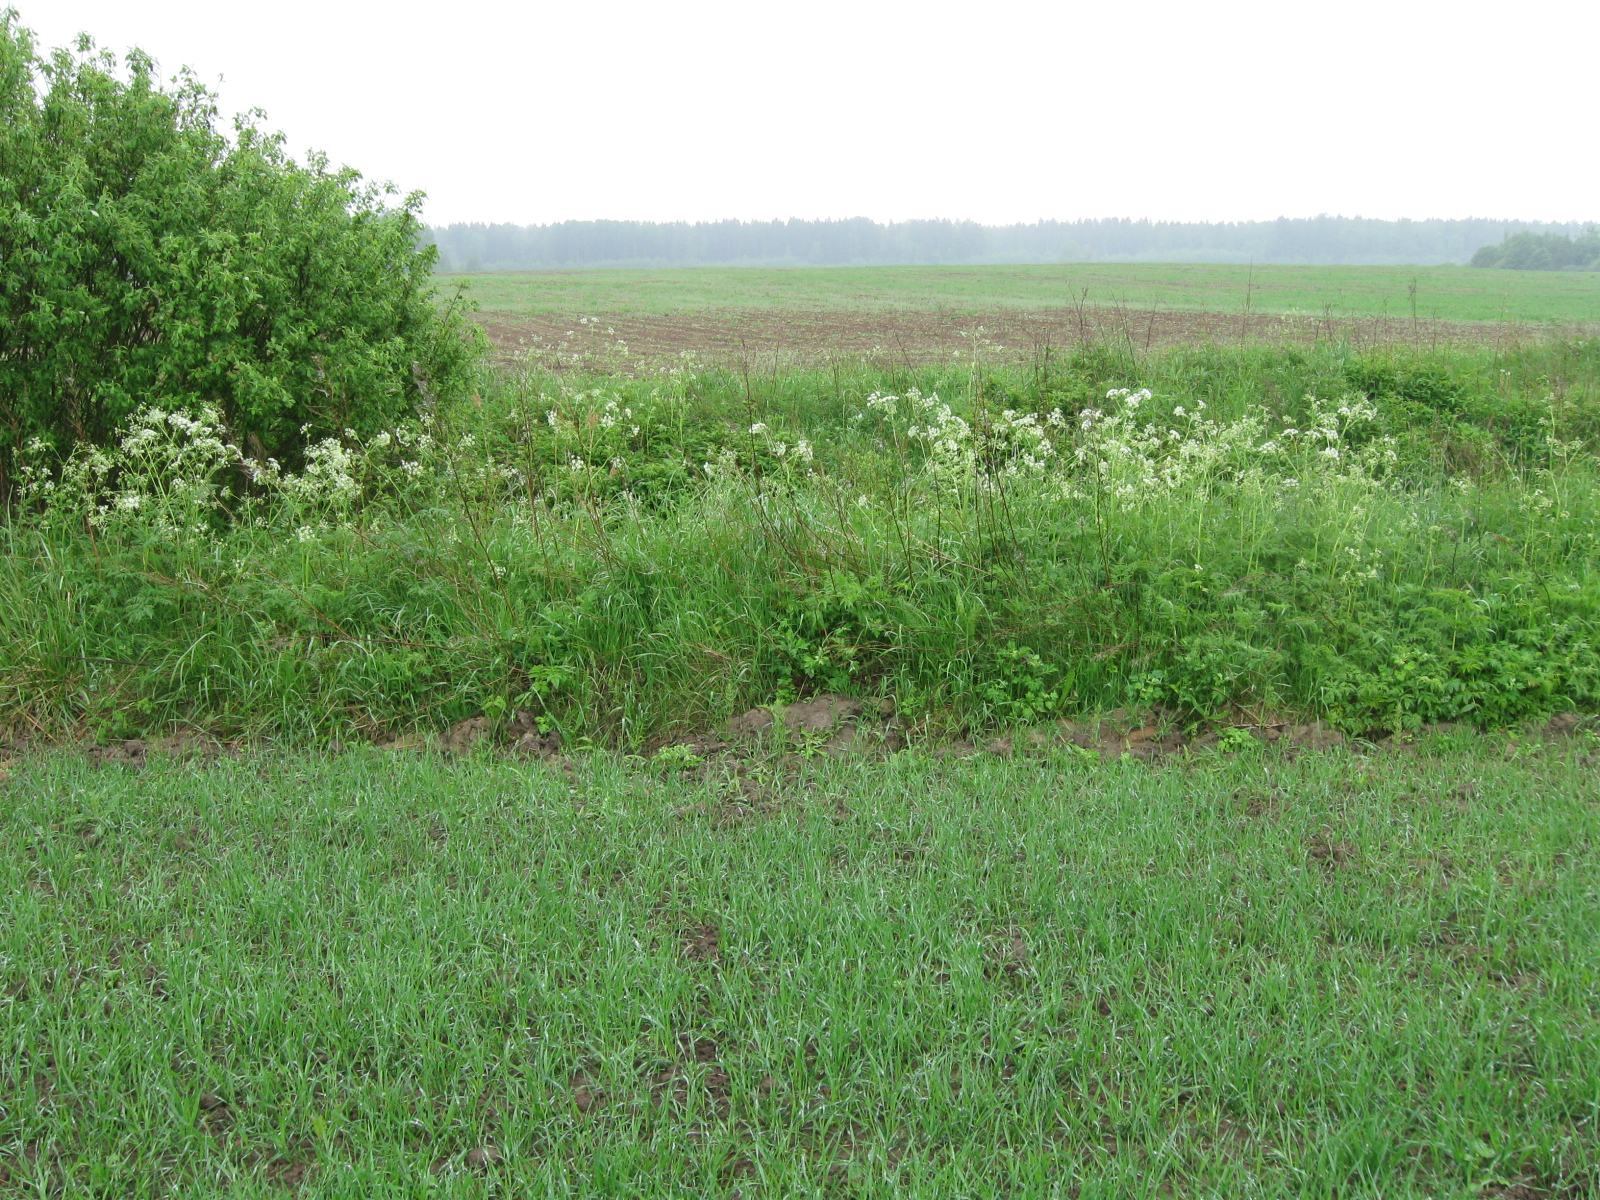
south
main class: Cropland
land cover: Common wheat
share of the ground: > 75 %
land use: Agriculture (excluding fallow land and kitchen gardens)
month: May
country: LT
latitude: 55.0052
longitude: 22.7149
